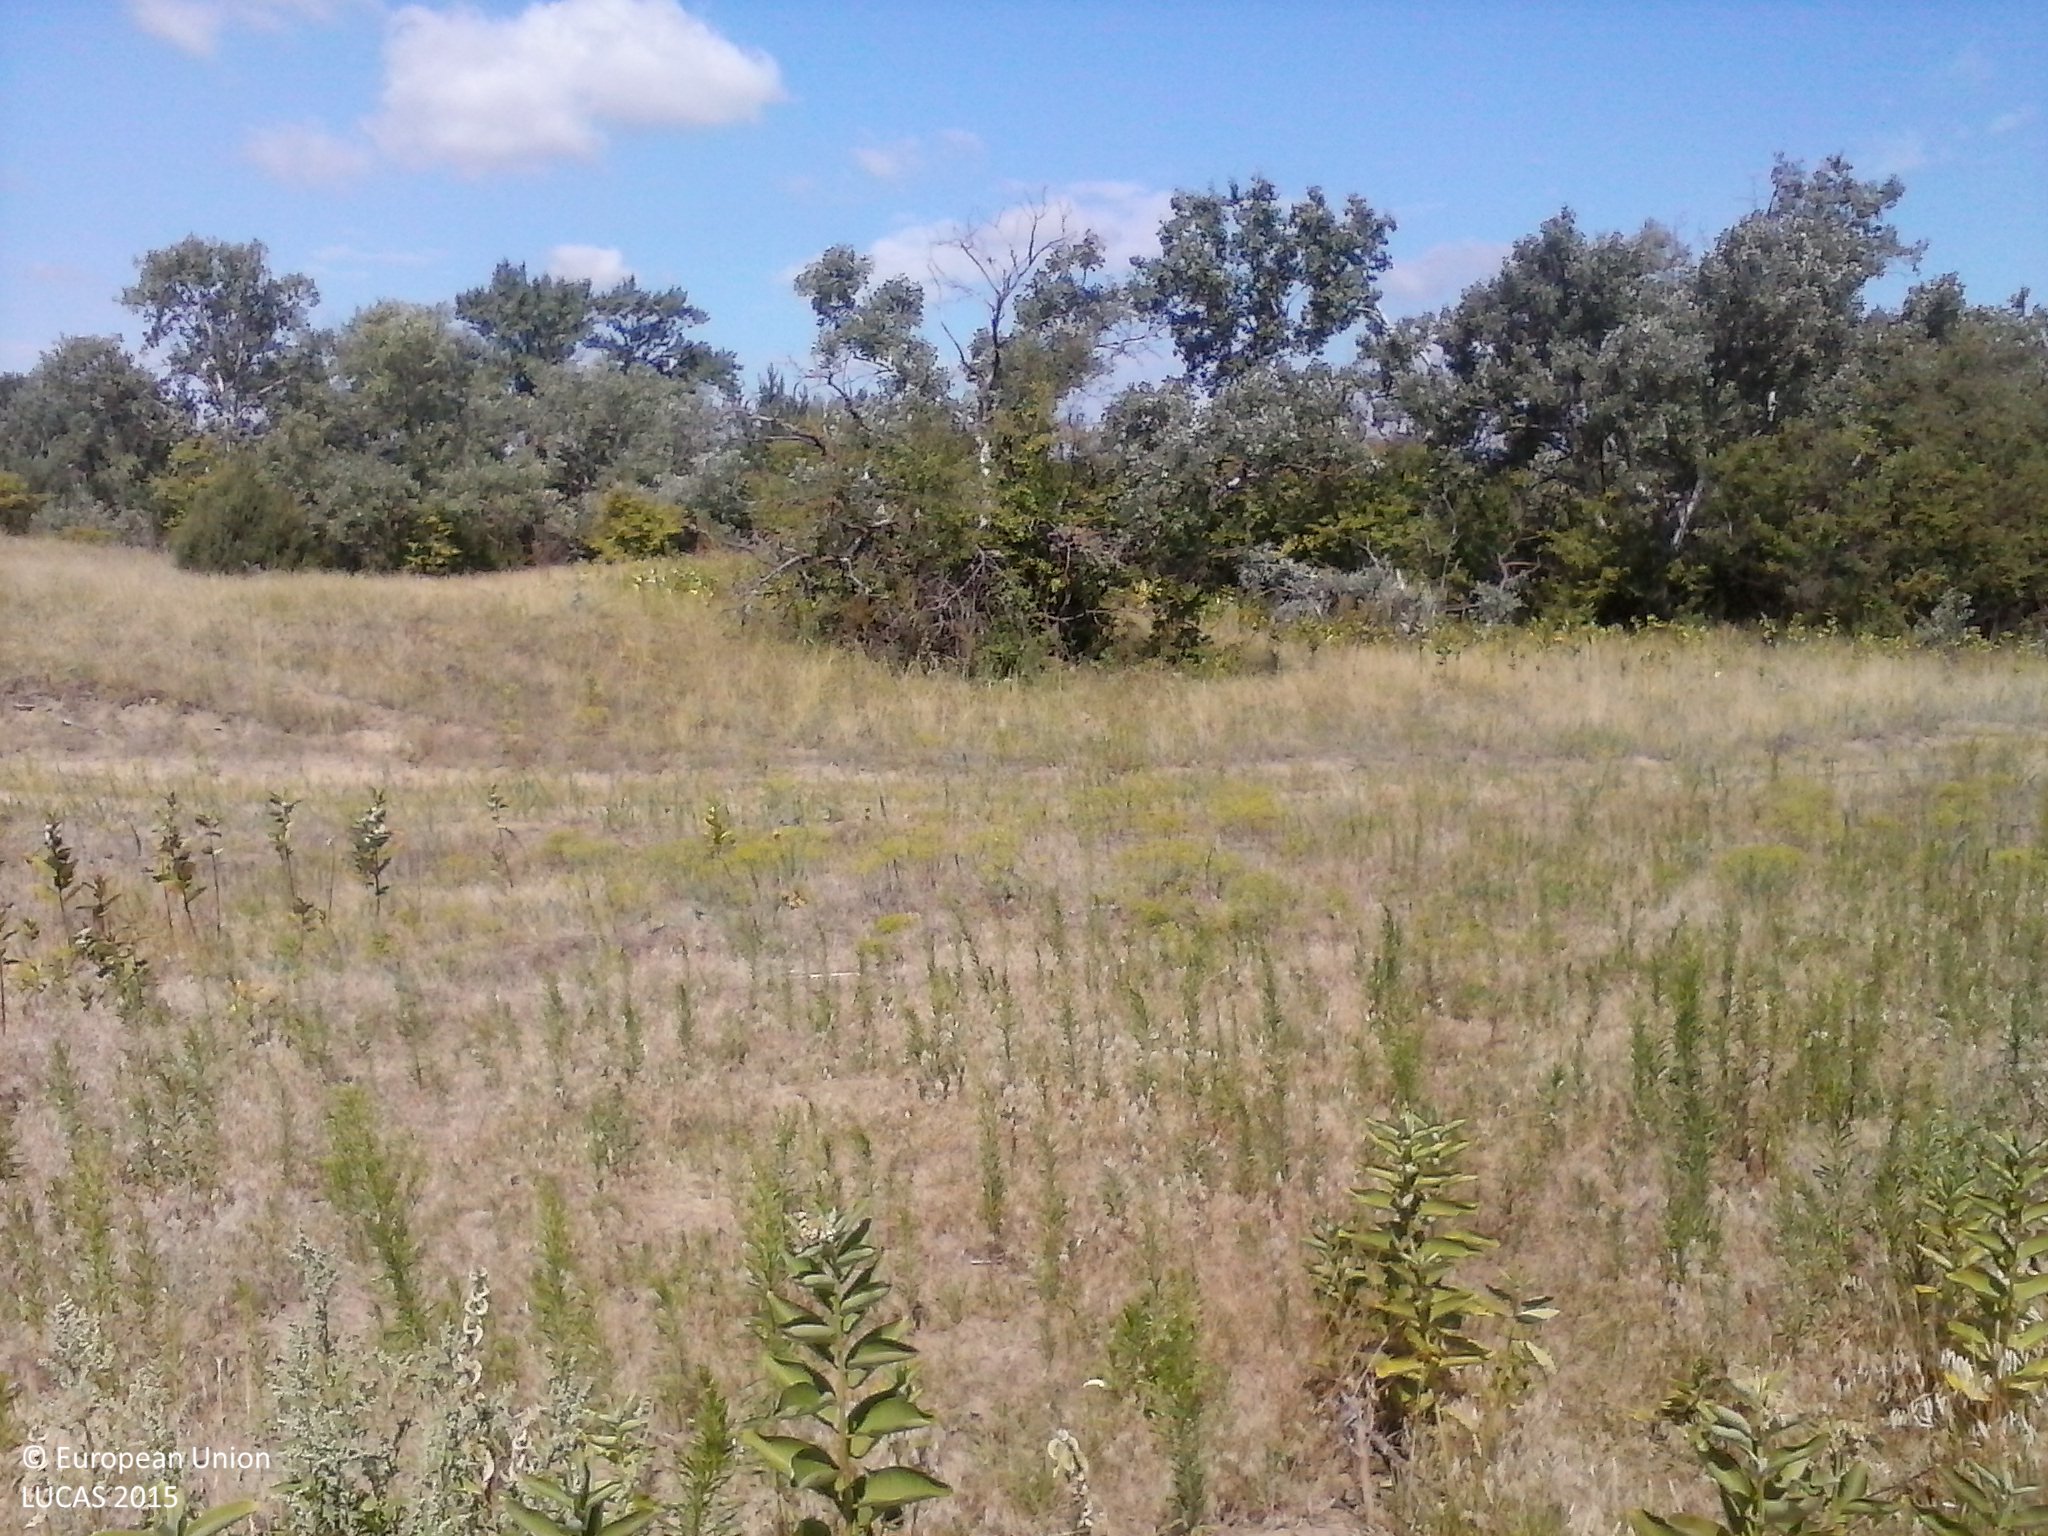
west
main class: Grassland
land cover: Spontaneously vegetated surfaces
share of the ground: 50 - 75 %
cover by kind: herbaceous plants 70 %, unconsolidated bare surface 25 %
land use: Forestry
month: July
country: HU
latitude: 46.5930
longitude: 19.5597
